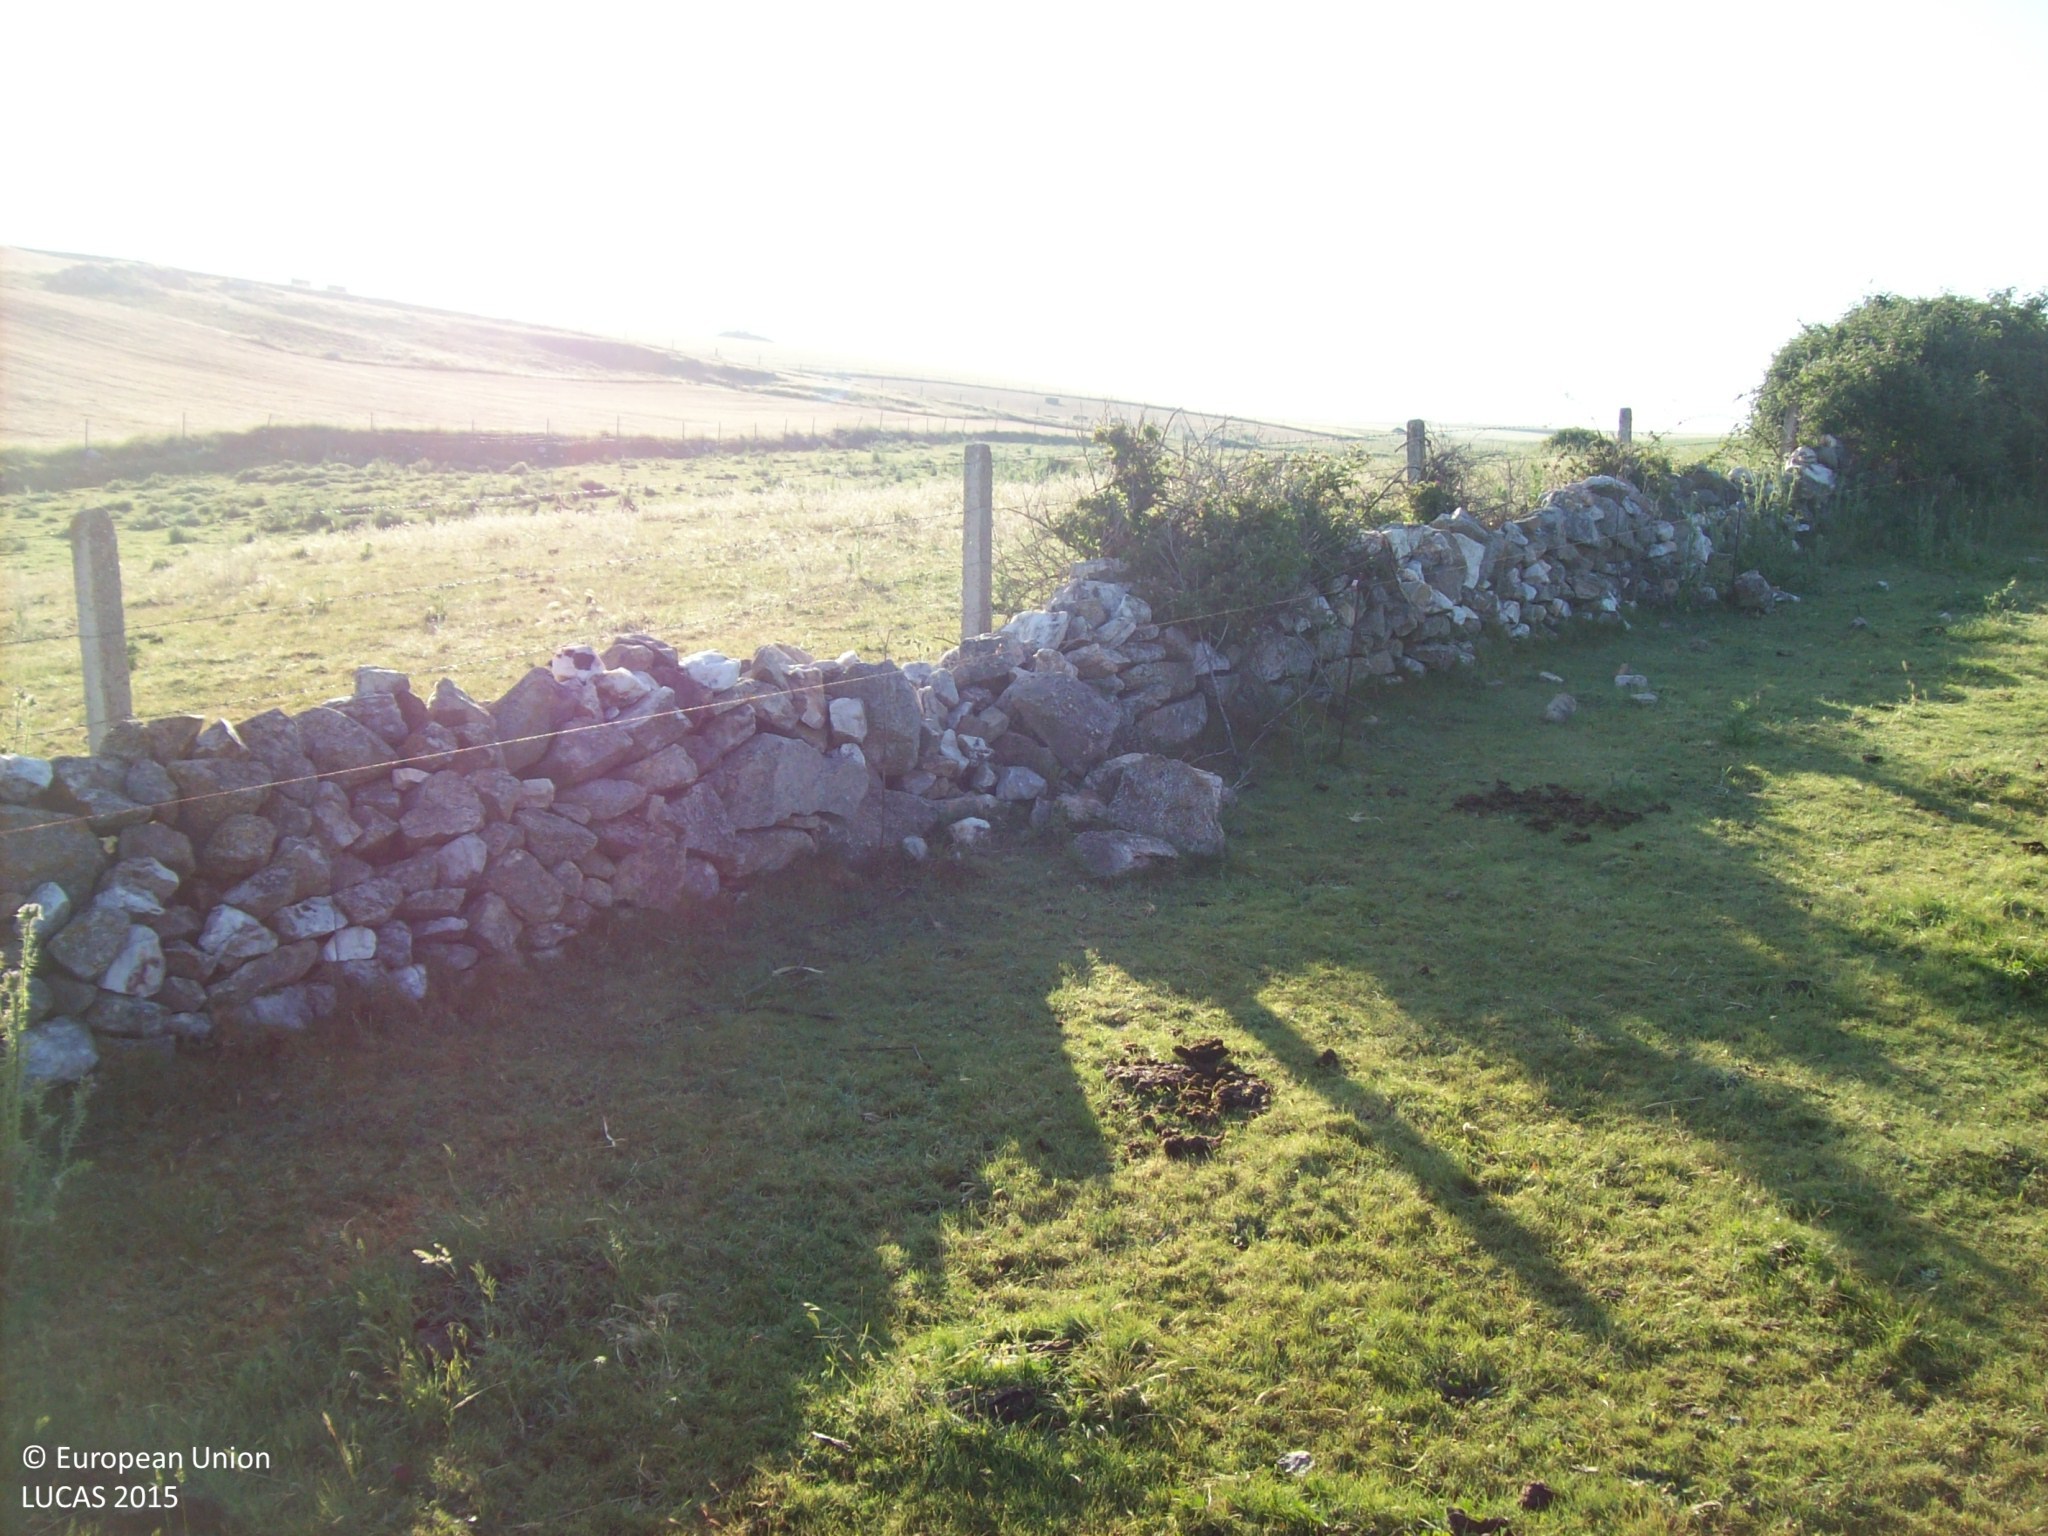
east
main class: Grassland
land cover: Grassland without tree/shrub cover
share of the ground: > 75 %
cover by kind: herbaceous plants 100 %
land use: Agriculture (excluding fallow land and kitchen gardens)
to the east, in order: Grassland without tree/shrub cover; Dry stone walls; Fences; Grassland without tree/shrub cover; Fences; Mixed cereals for fodder; Fences; Tracks; Fences; Grassland without tree/shrub cover
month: May
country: ES
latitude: 40.7591
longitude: -5.1197
